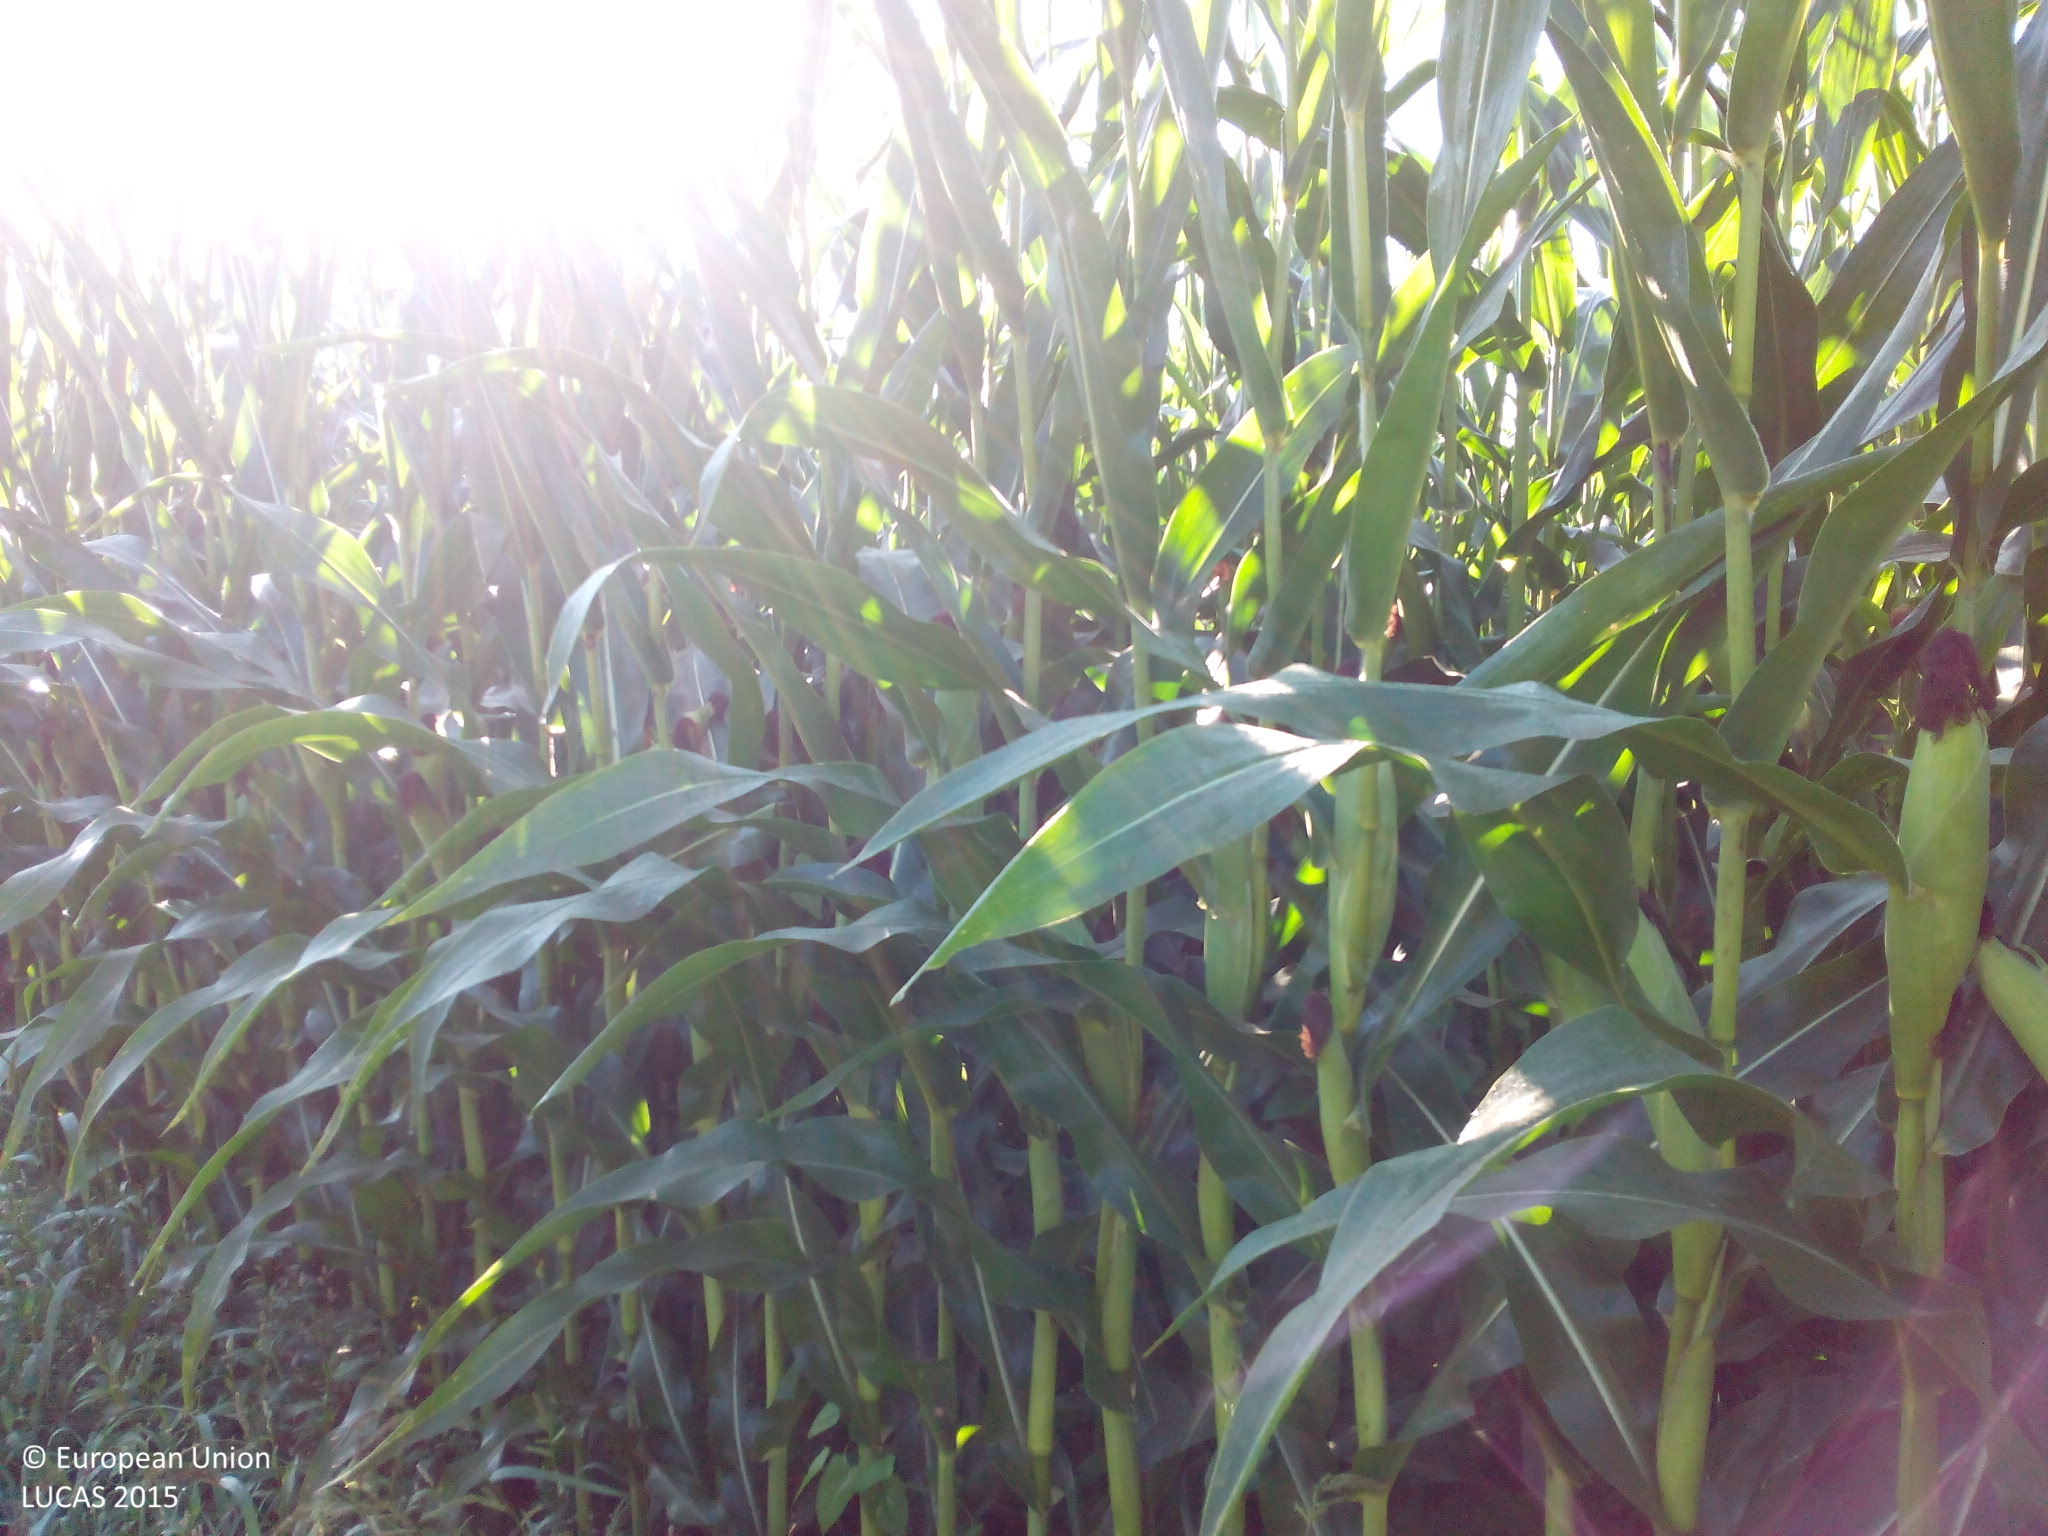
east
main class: Cropland
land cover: Maize
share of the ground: > 75 %
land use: Agriculture (excluding fallow land and kitchen gardens)
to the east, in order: Maize; Grassland without tree/shrub cover; Paved roads, cycling and walking lanes; Grass margins; Managed hedges; Tracks; Grass margins; Maize
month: August
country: DE
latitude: 48.0259
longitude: 12.8014
